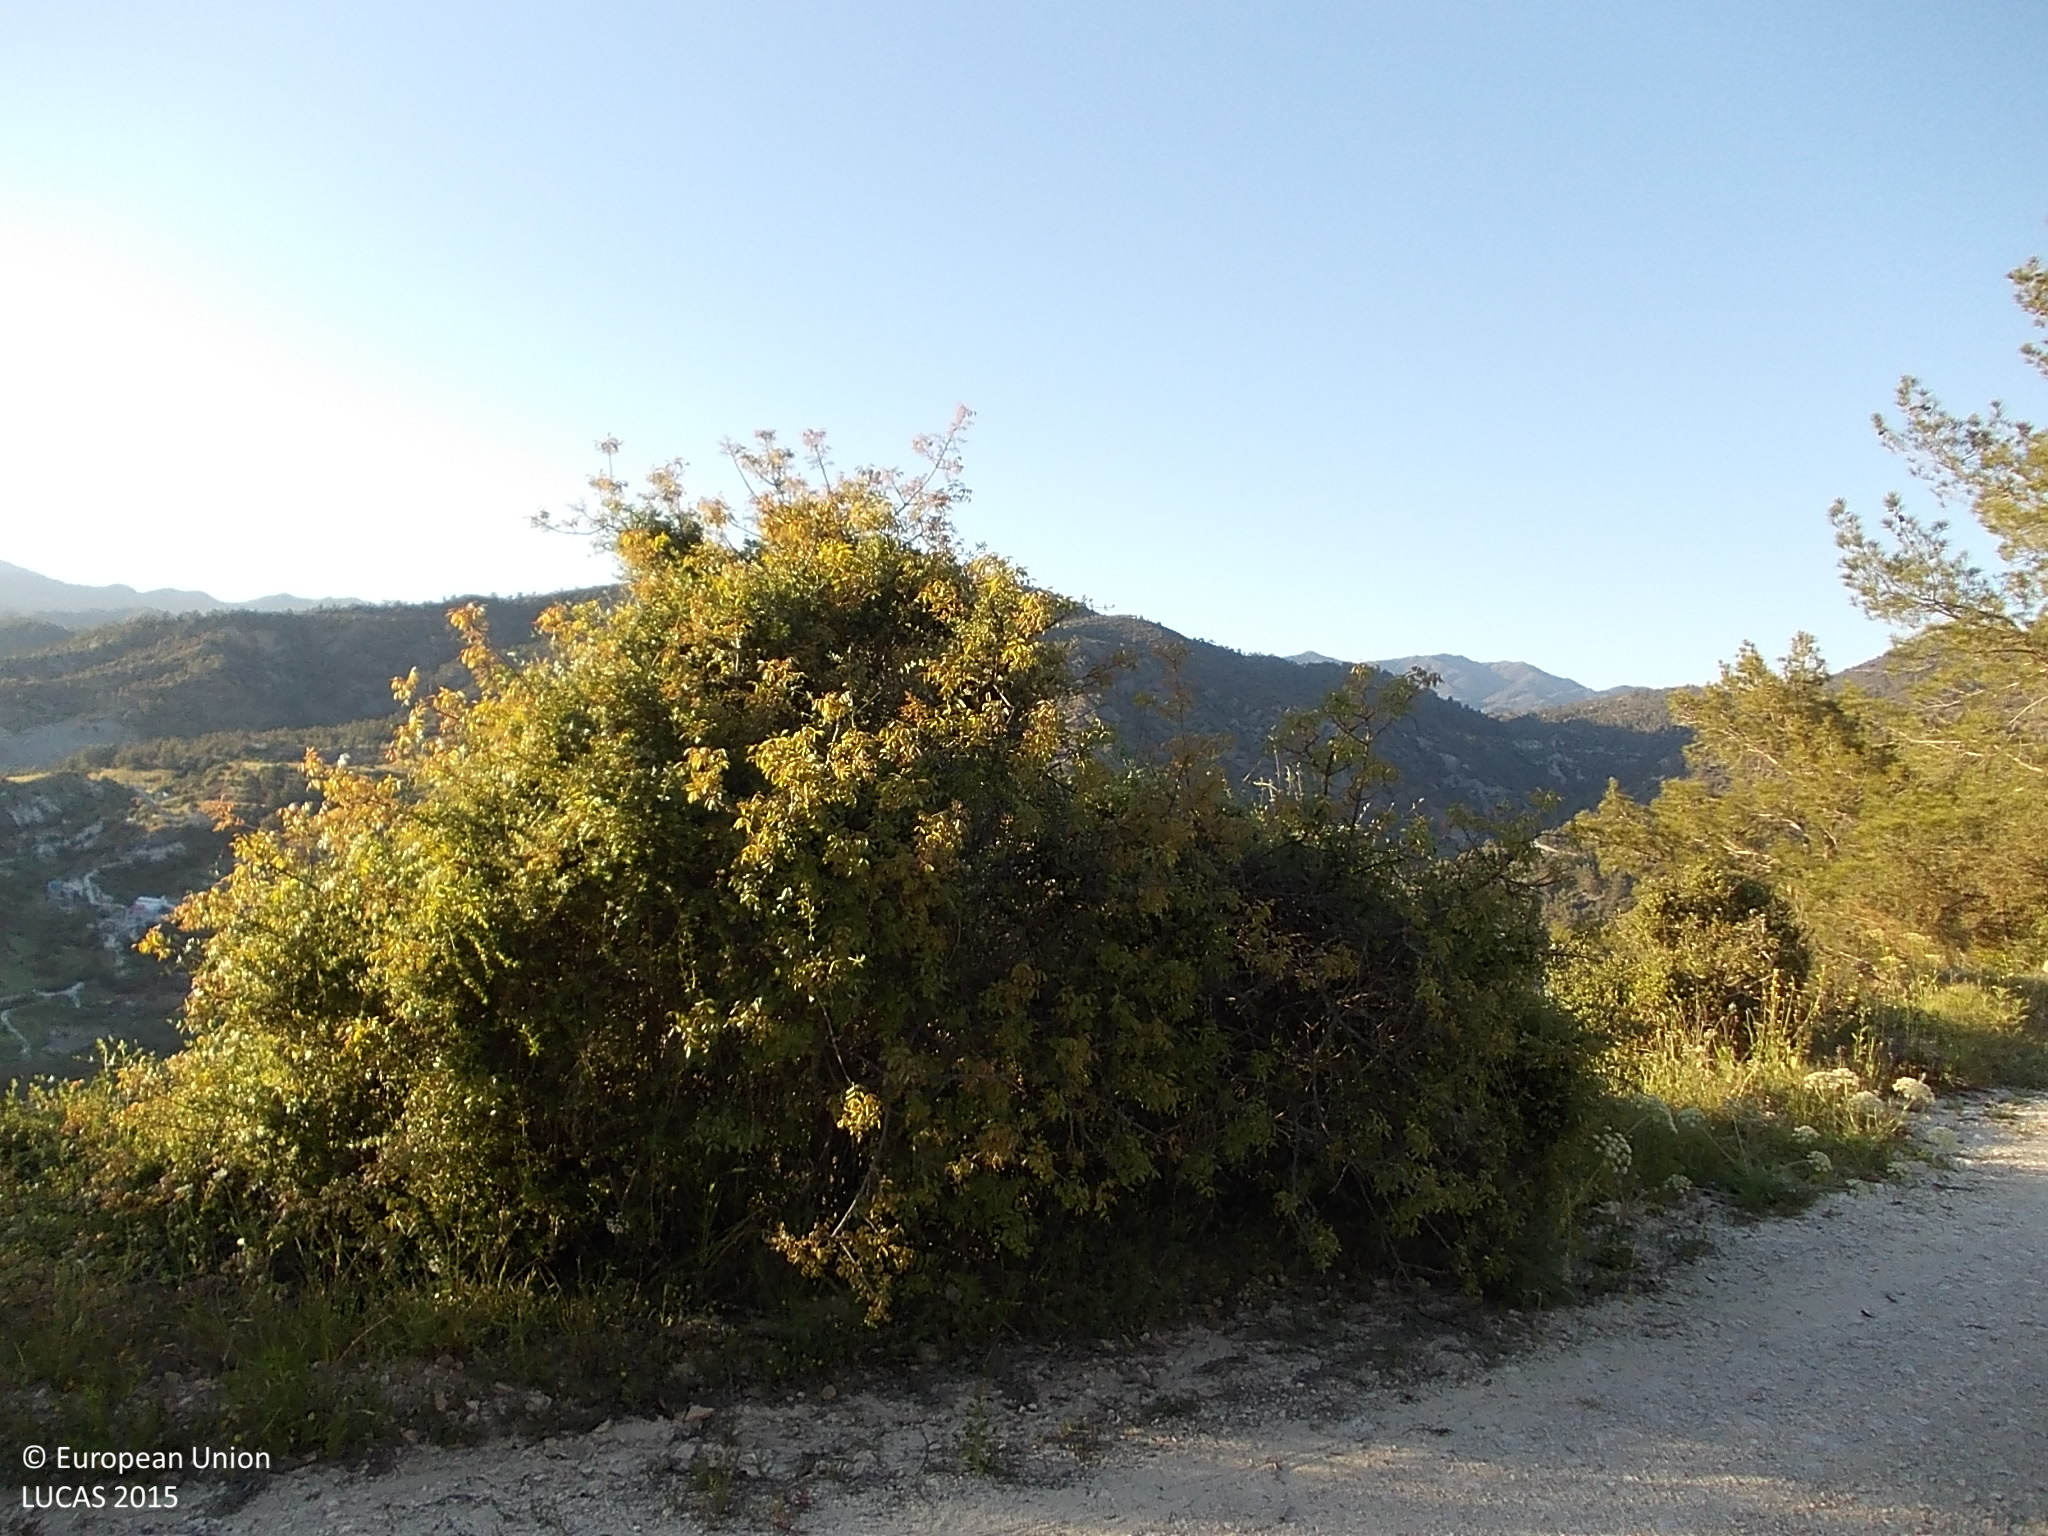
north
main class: Woodland
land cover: Pine dominated coniferous woodland
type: coniferous forest of the mediterranean region
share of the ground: 10 - 25 %
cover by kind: shrubs 65 %, unconsolidated bare surface 20 %, coniferous forest trees 15 %
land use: Forestry
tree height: > 5 m
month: April
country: CY
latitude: 34.7890
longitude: 33.0196
